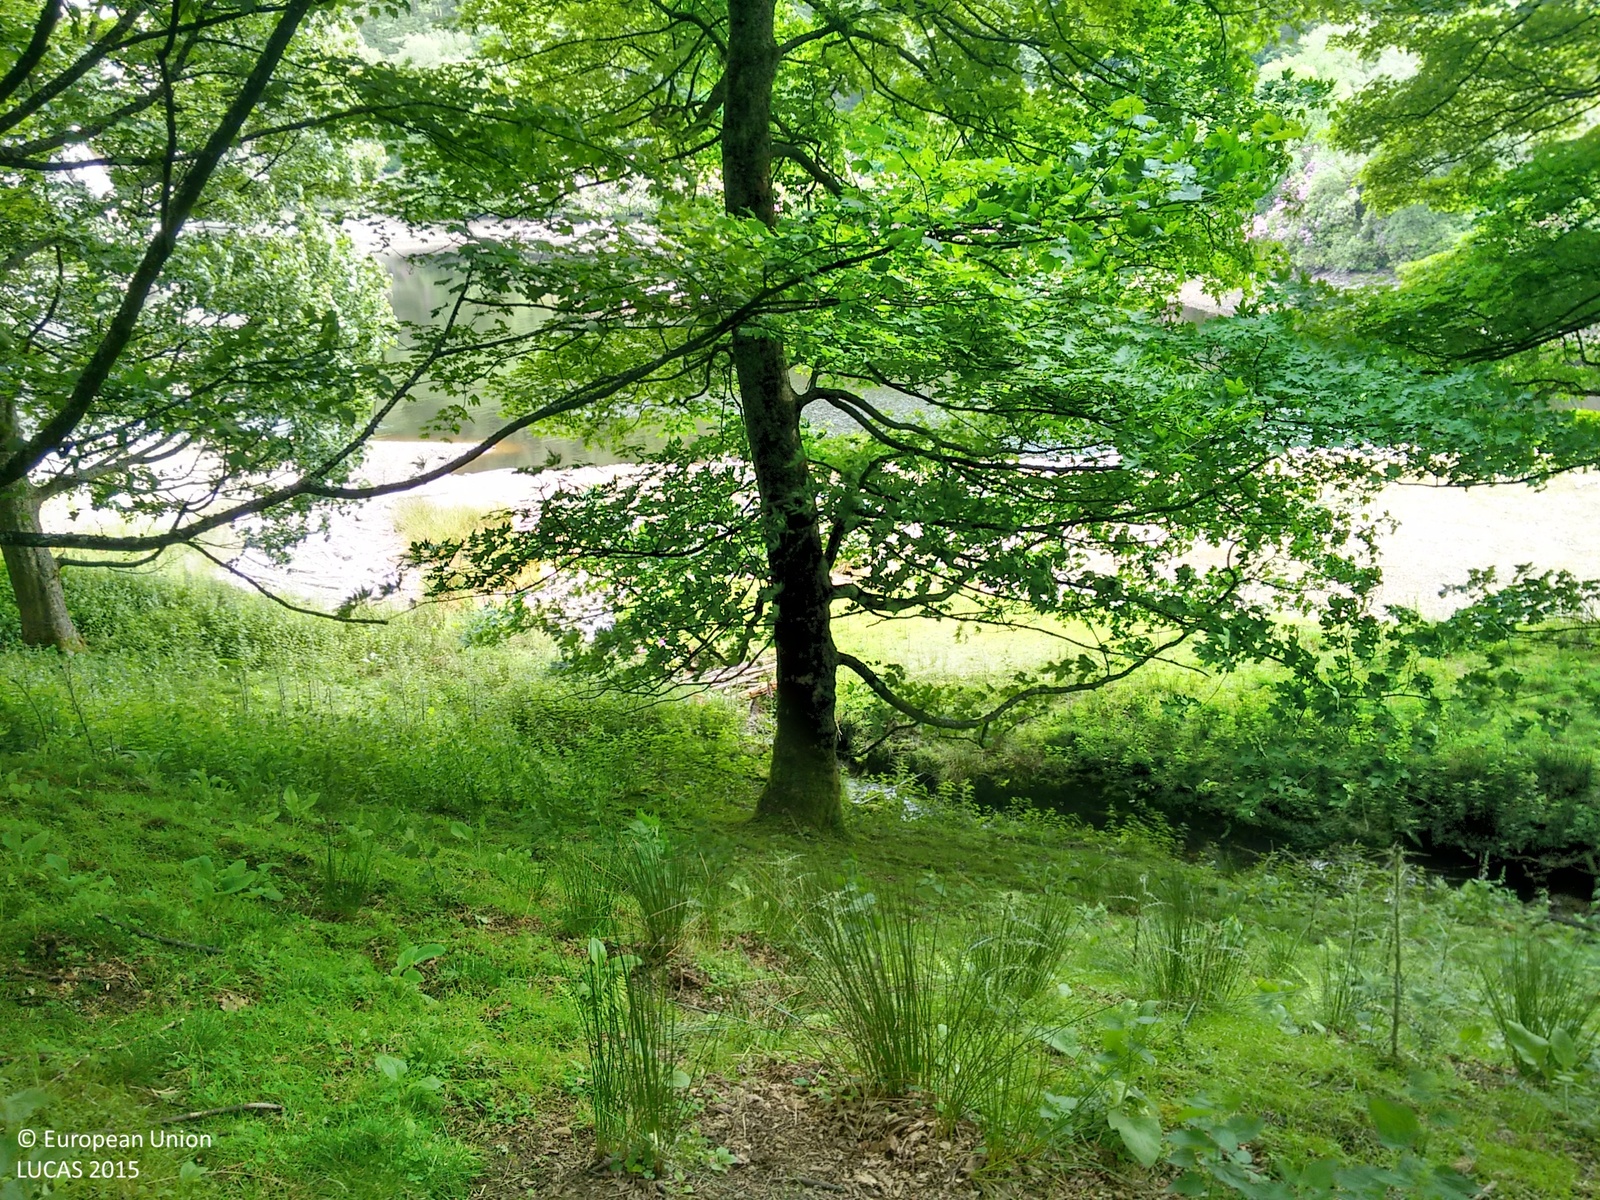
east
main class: Woodland
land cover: Broadleaved woodland
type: mesophytic deciduous forest
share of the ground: > 75 %
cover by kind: broadleaved forest trees 100 %
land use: Amenities, museums, leisure
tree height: > 5 m
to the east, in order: Broadleaved woodland; Rivers and streams; Grassland without tree/shrub cover; Sand; Inland fresh water bodies; Spruce dominated mixed woodland; Tracks; Spruce dominated coniferous woodland
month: June
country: GB
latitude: 53.4276
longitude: -1.7474
